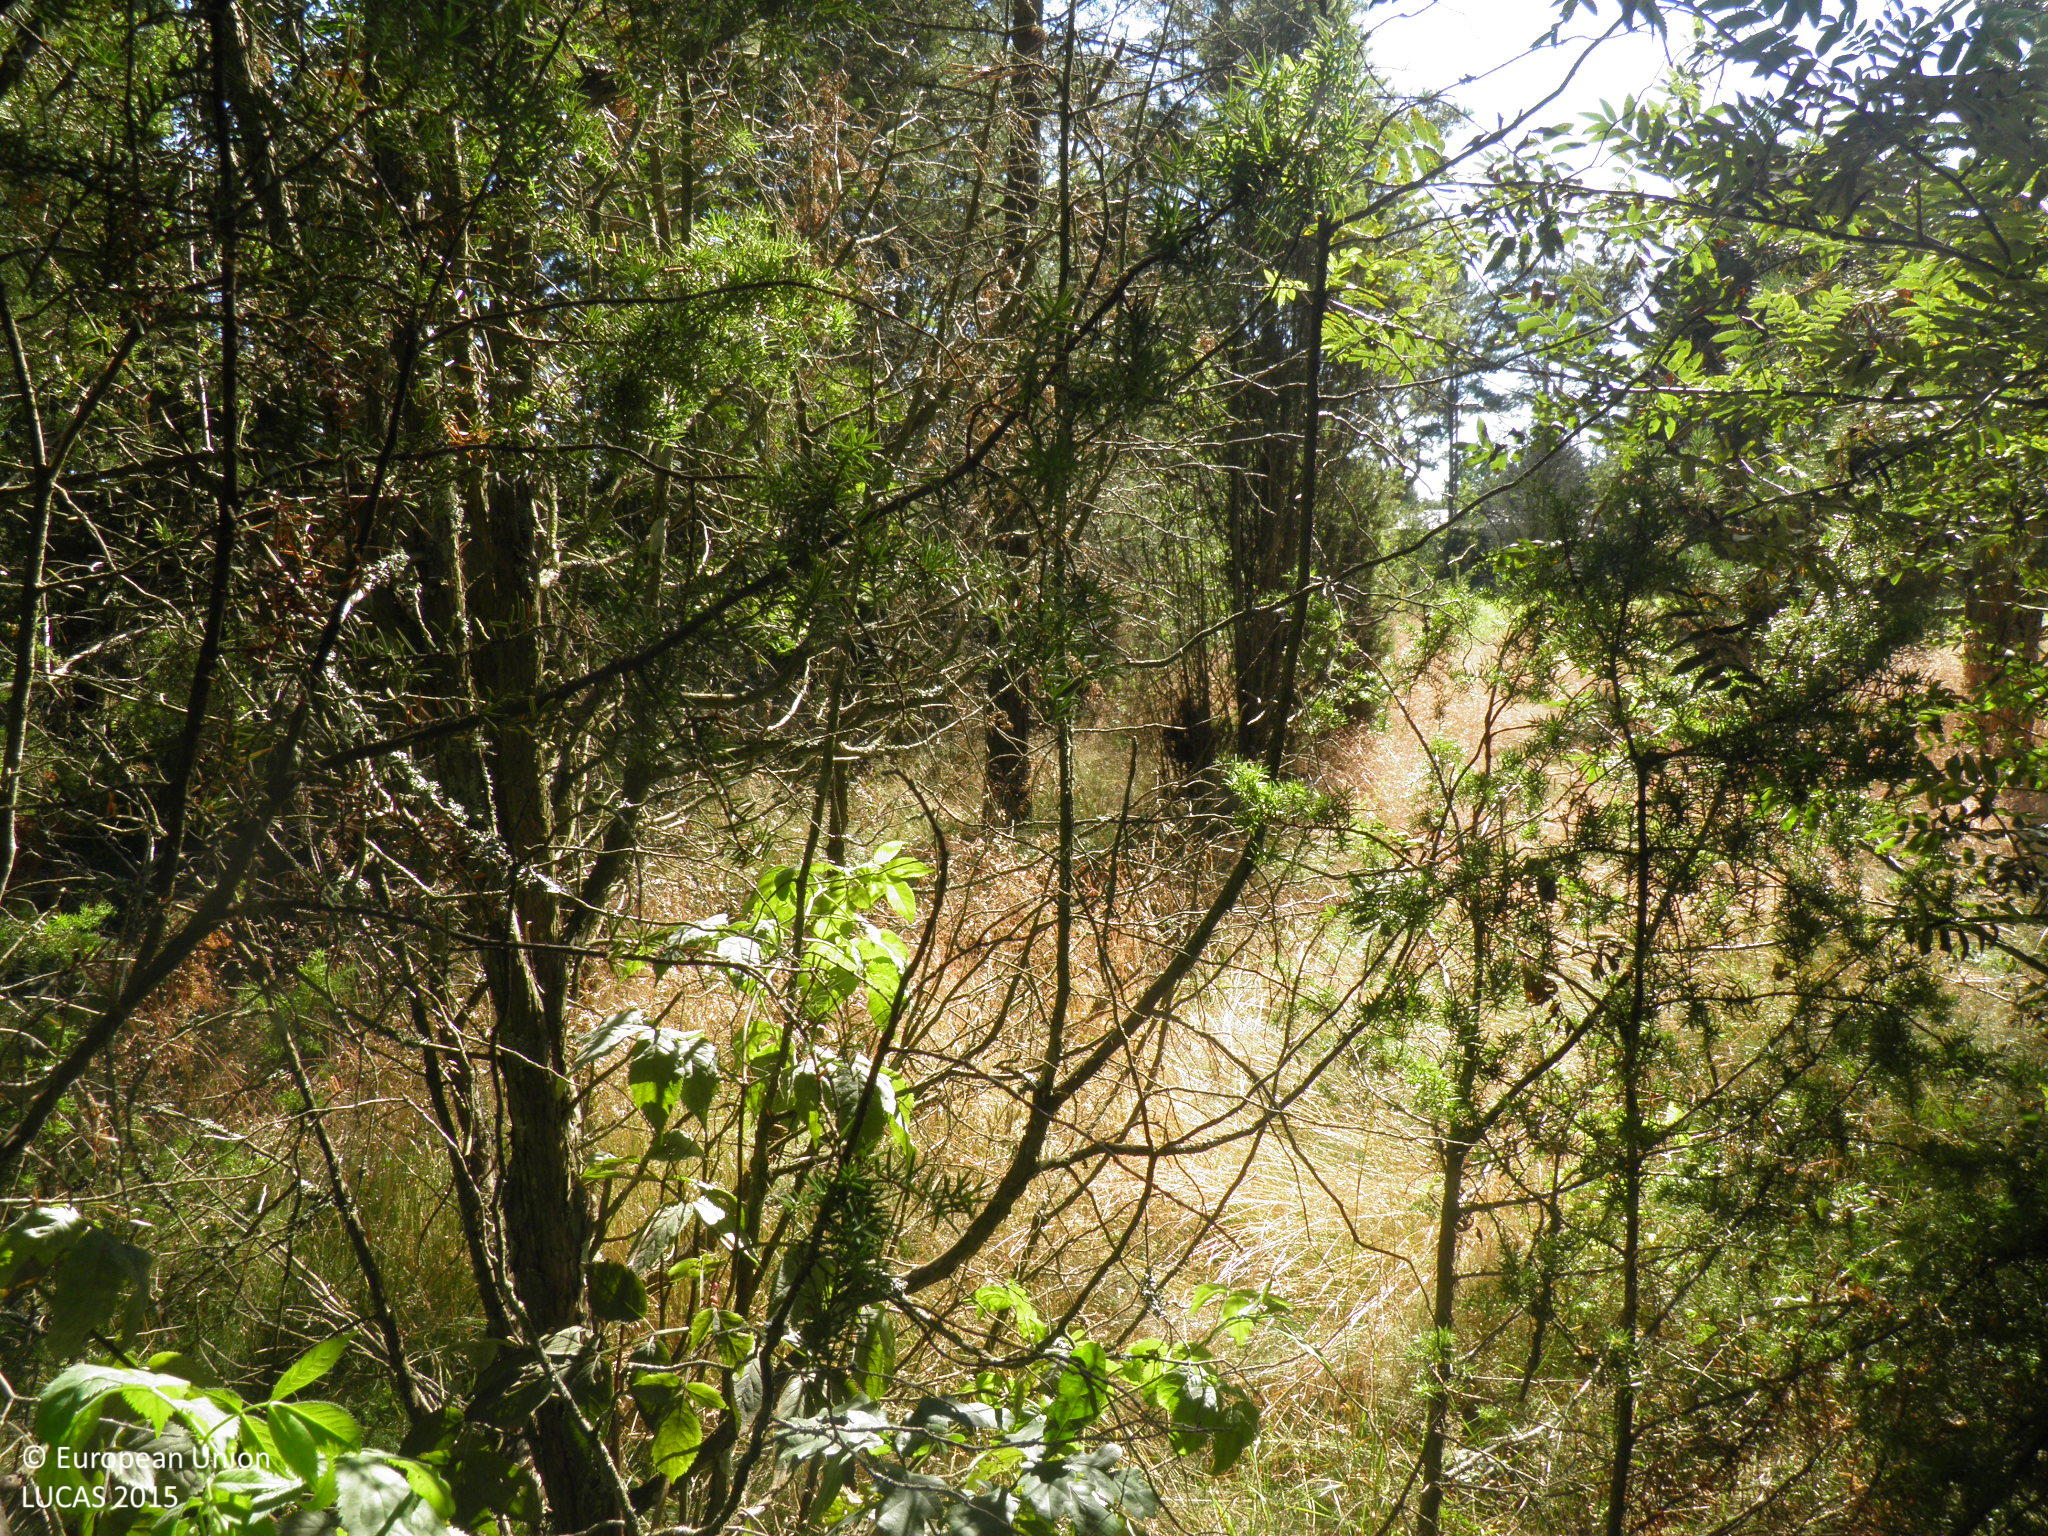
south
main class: Woodland
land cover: Pine dominated mixed woodland
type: hemiboreal forest and nemoral coniferous forest and mixed broadleaved-coniferous forest
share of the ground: > 75 %
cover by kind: coniferous forest trees 55 %, broadleaved forest trees 35 %, herbaceous plants 10 %
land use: Abandoned areas
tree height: > 5 m
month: August
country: FI
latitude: 60.8166
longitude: 21.5460
